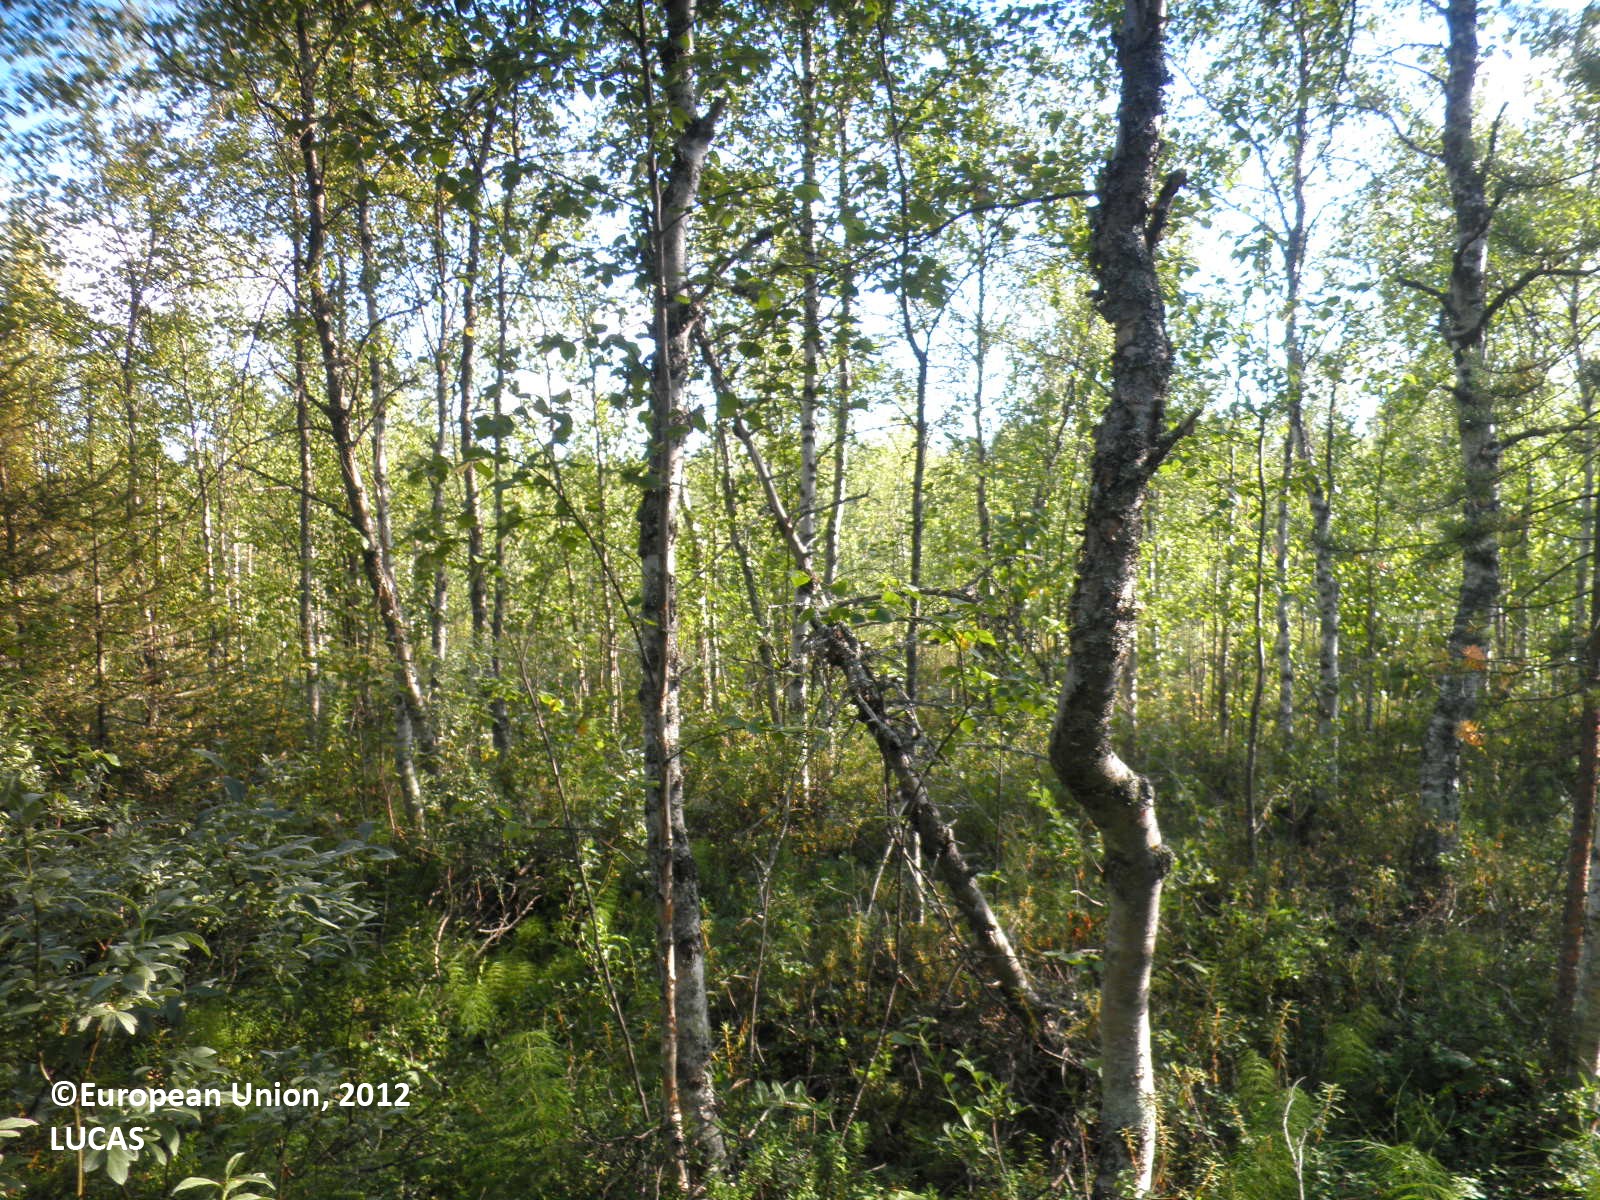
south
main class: Woodland
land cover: Spruce dominated mixed woodland
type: boreal forest
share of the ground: > 75 %
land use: Forestry
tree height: > 5 m
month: August
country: FI
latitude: 67.5382
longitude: 25.5049
